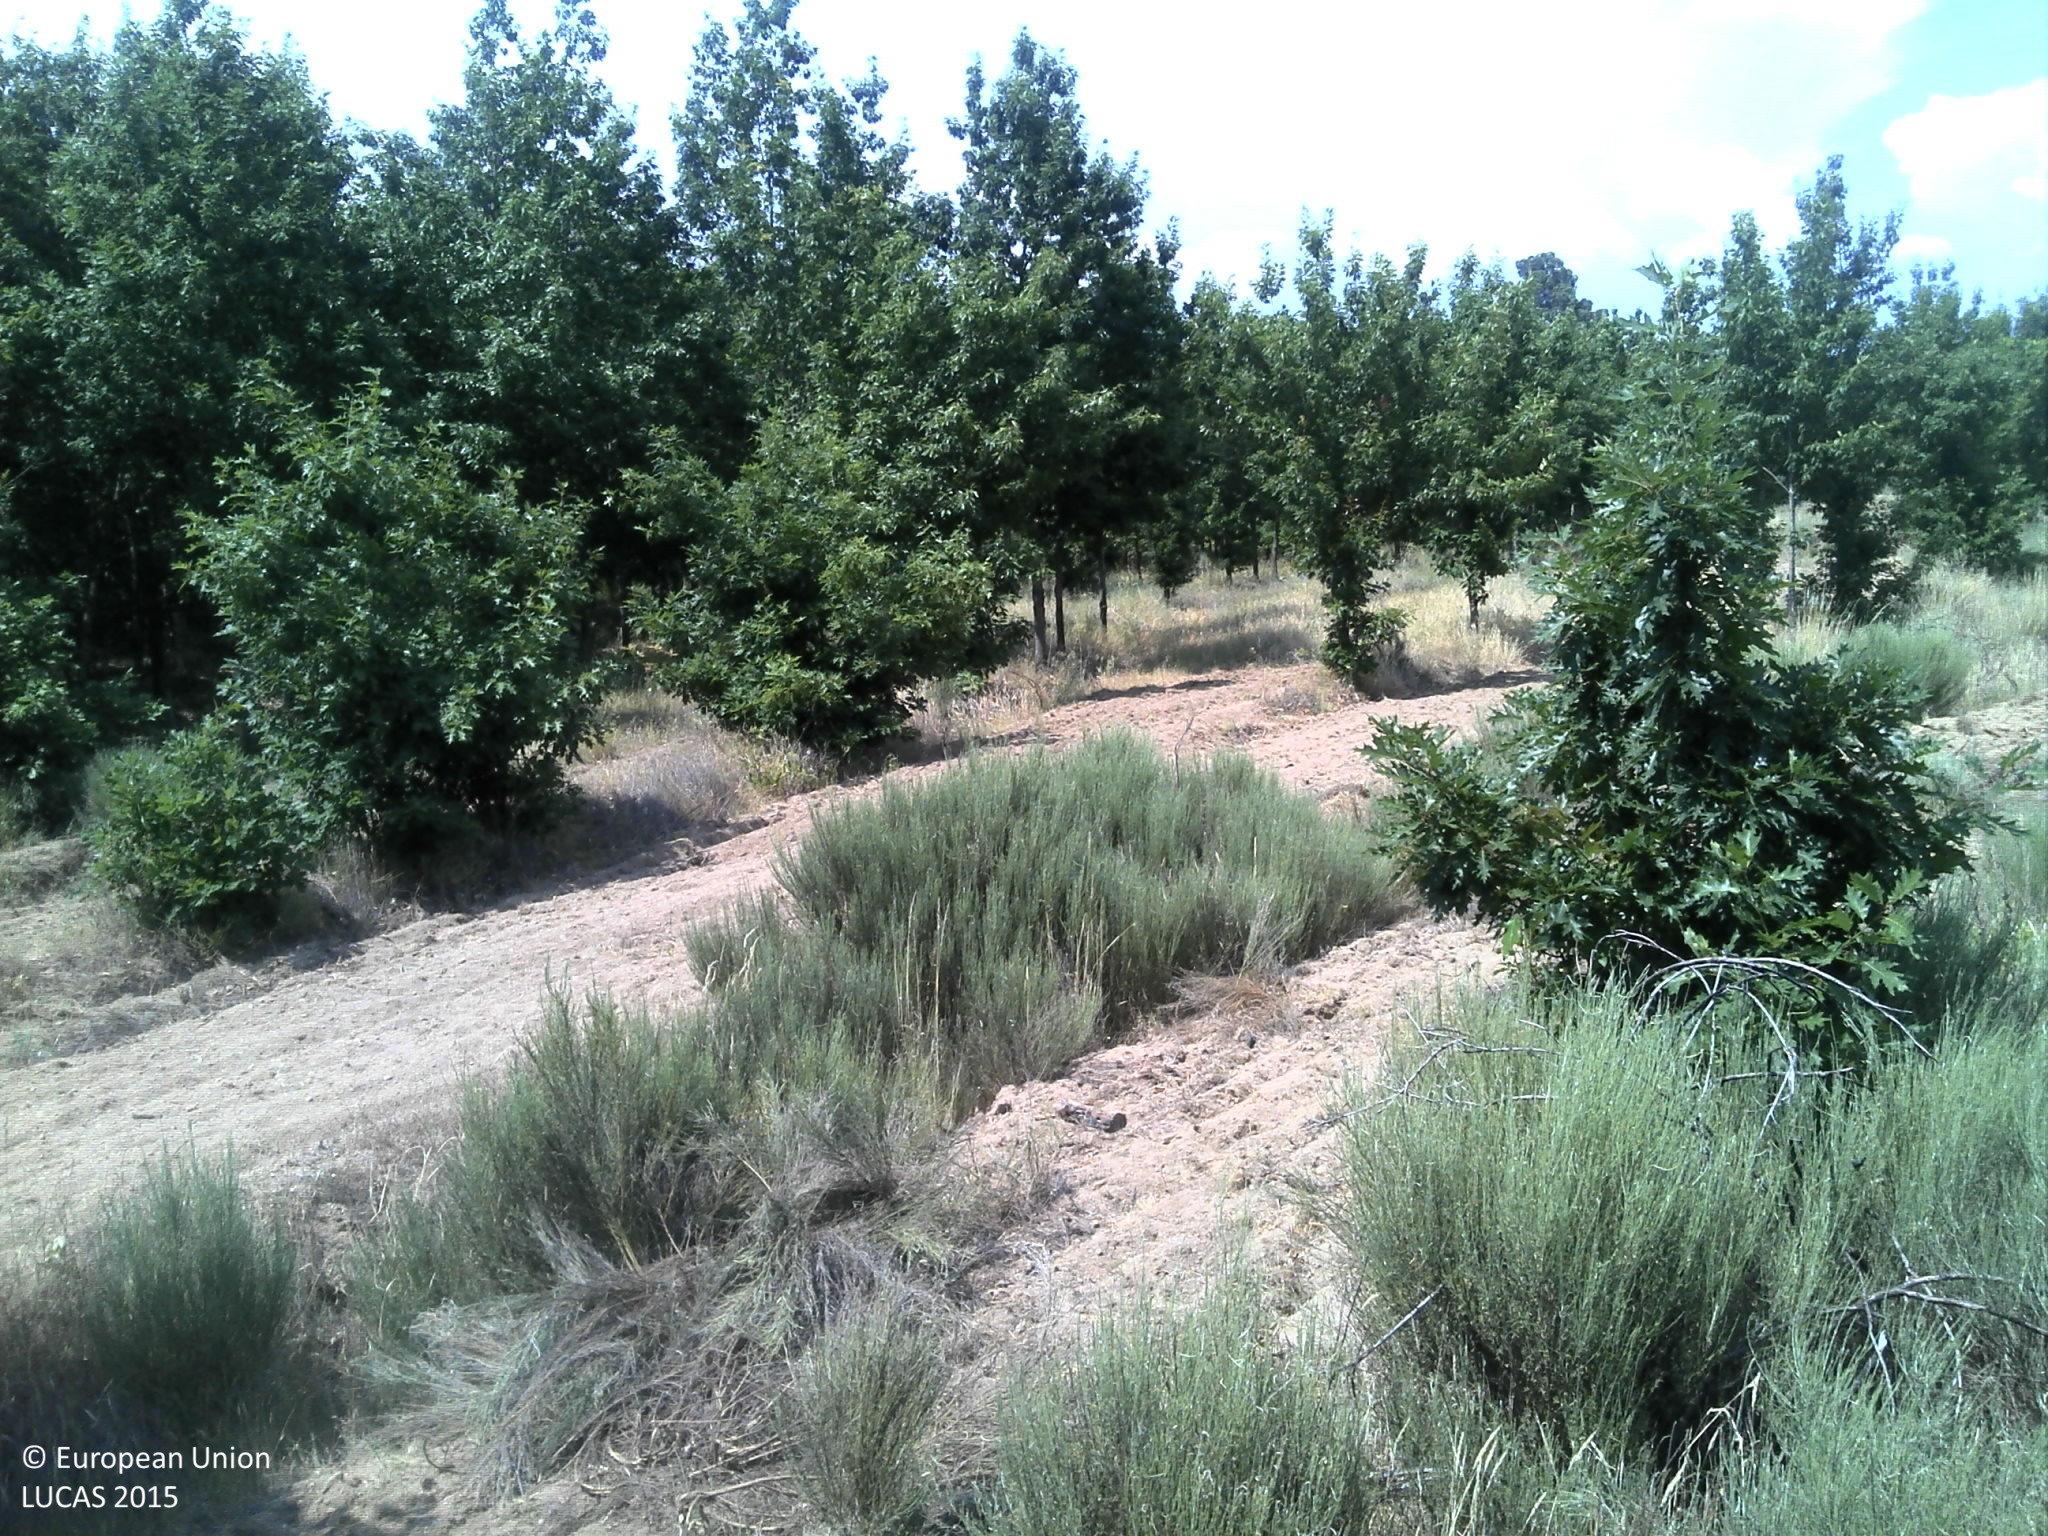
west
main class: Shrubland
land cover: Shrubland without tree cover
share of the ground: 50 - 75 %
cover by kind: shrubs 60 %, herbaceous plants 30 %, unconsolidated bare surface 5 %
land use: Abandoned areas
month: June
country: PT
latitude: 40.3011
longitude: -7.3154
